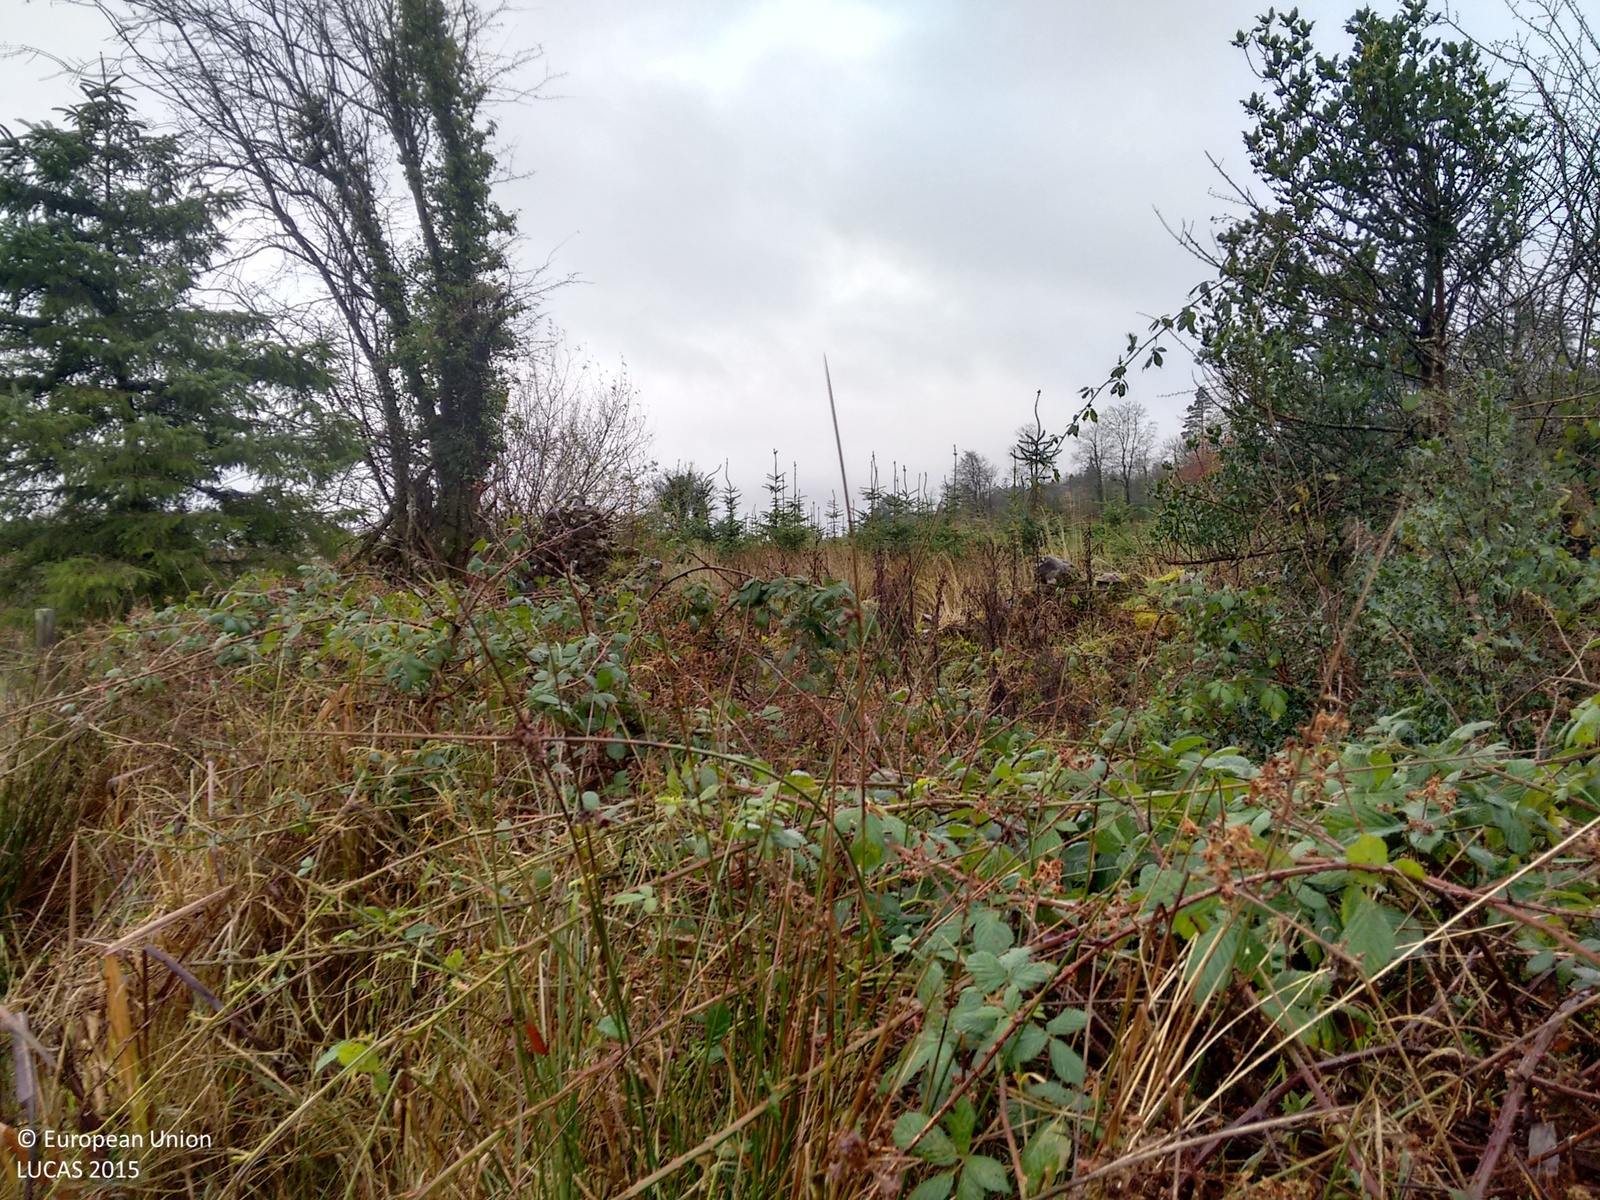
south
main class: Woodland
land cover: Spruce dominated coniferous woodland
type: exotic forest
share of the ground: > 75 %
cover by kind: coniferous forest trees 90 %, herbaceous plants 10 %
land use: Forestry
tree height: < 5 m
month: November
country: IE
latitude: 54.1979
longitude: -8.4780
